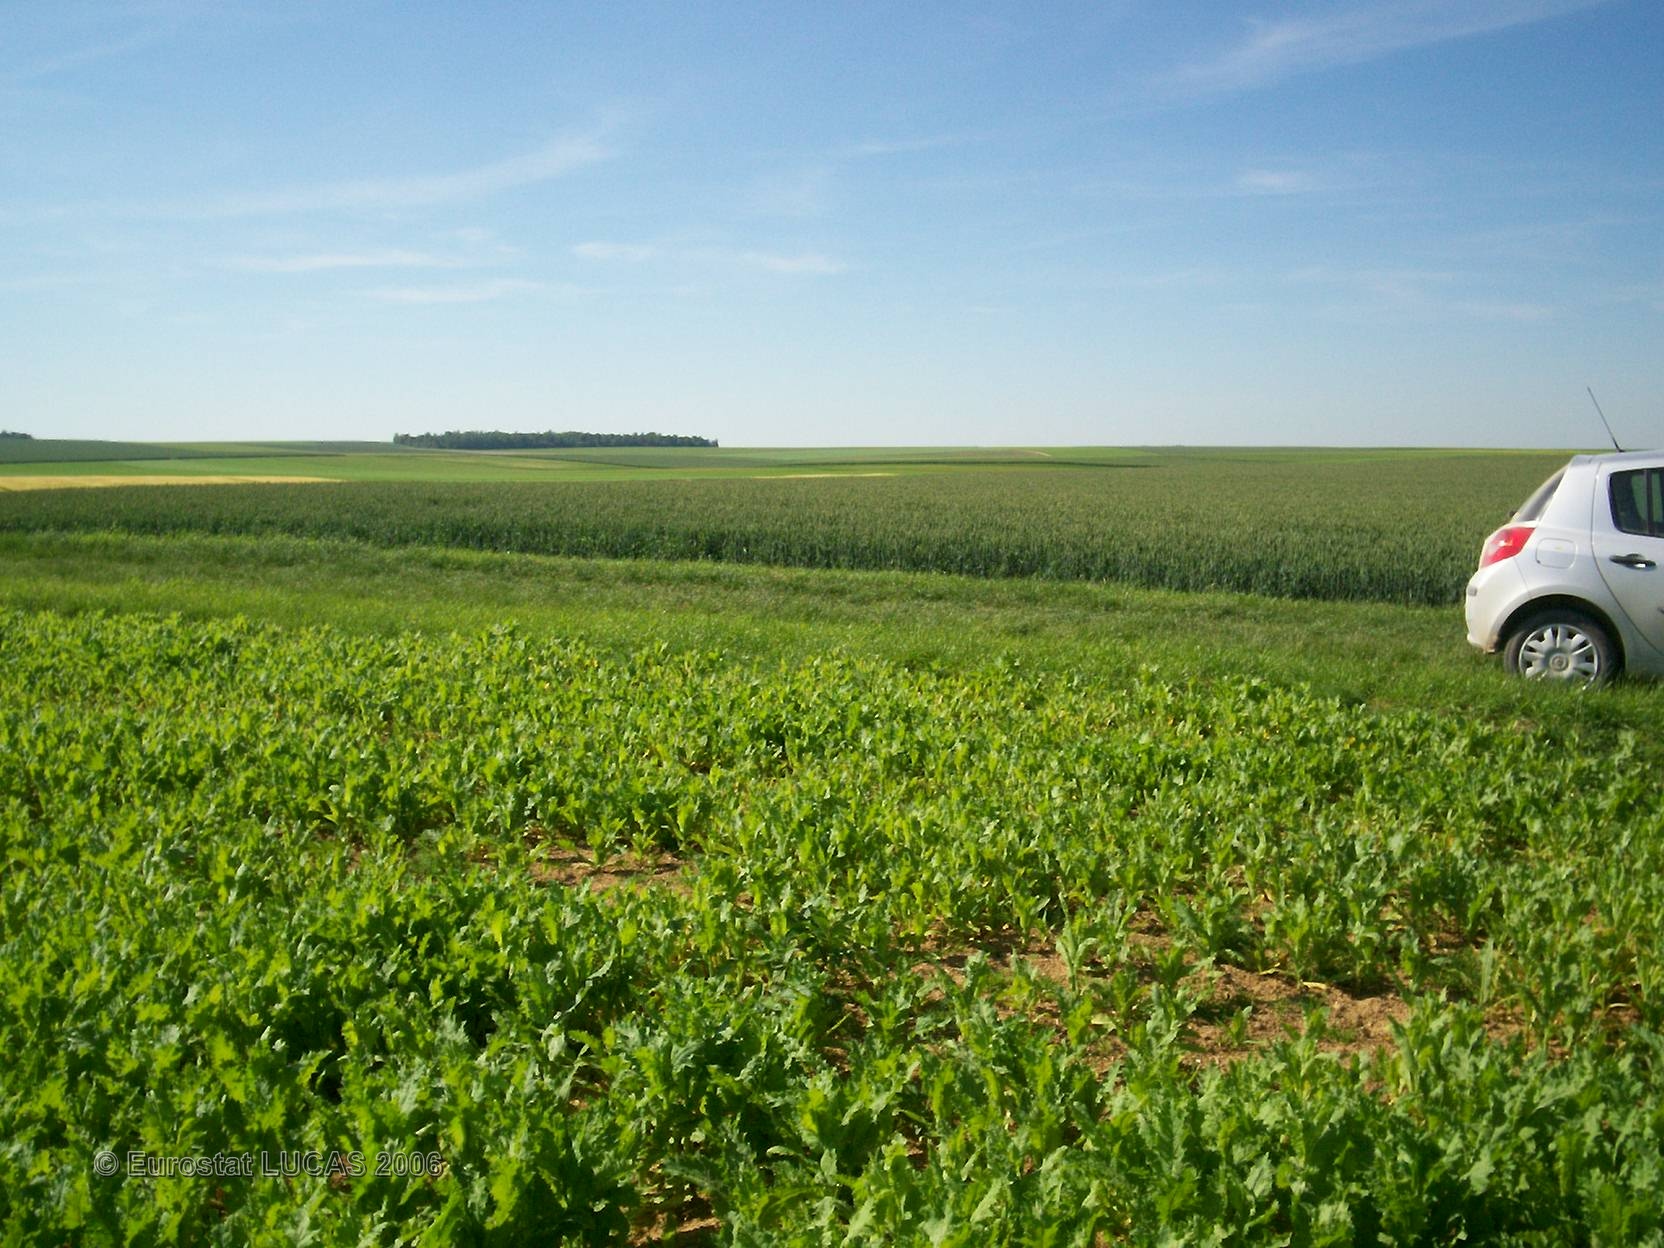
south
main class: Cropland
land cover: Other fibre and oleaginous crops
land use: Agriculture (excluding fallow land and kitchen gardens)
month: June
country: FR
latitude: 49.1017
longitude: 4.6140
